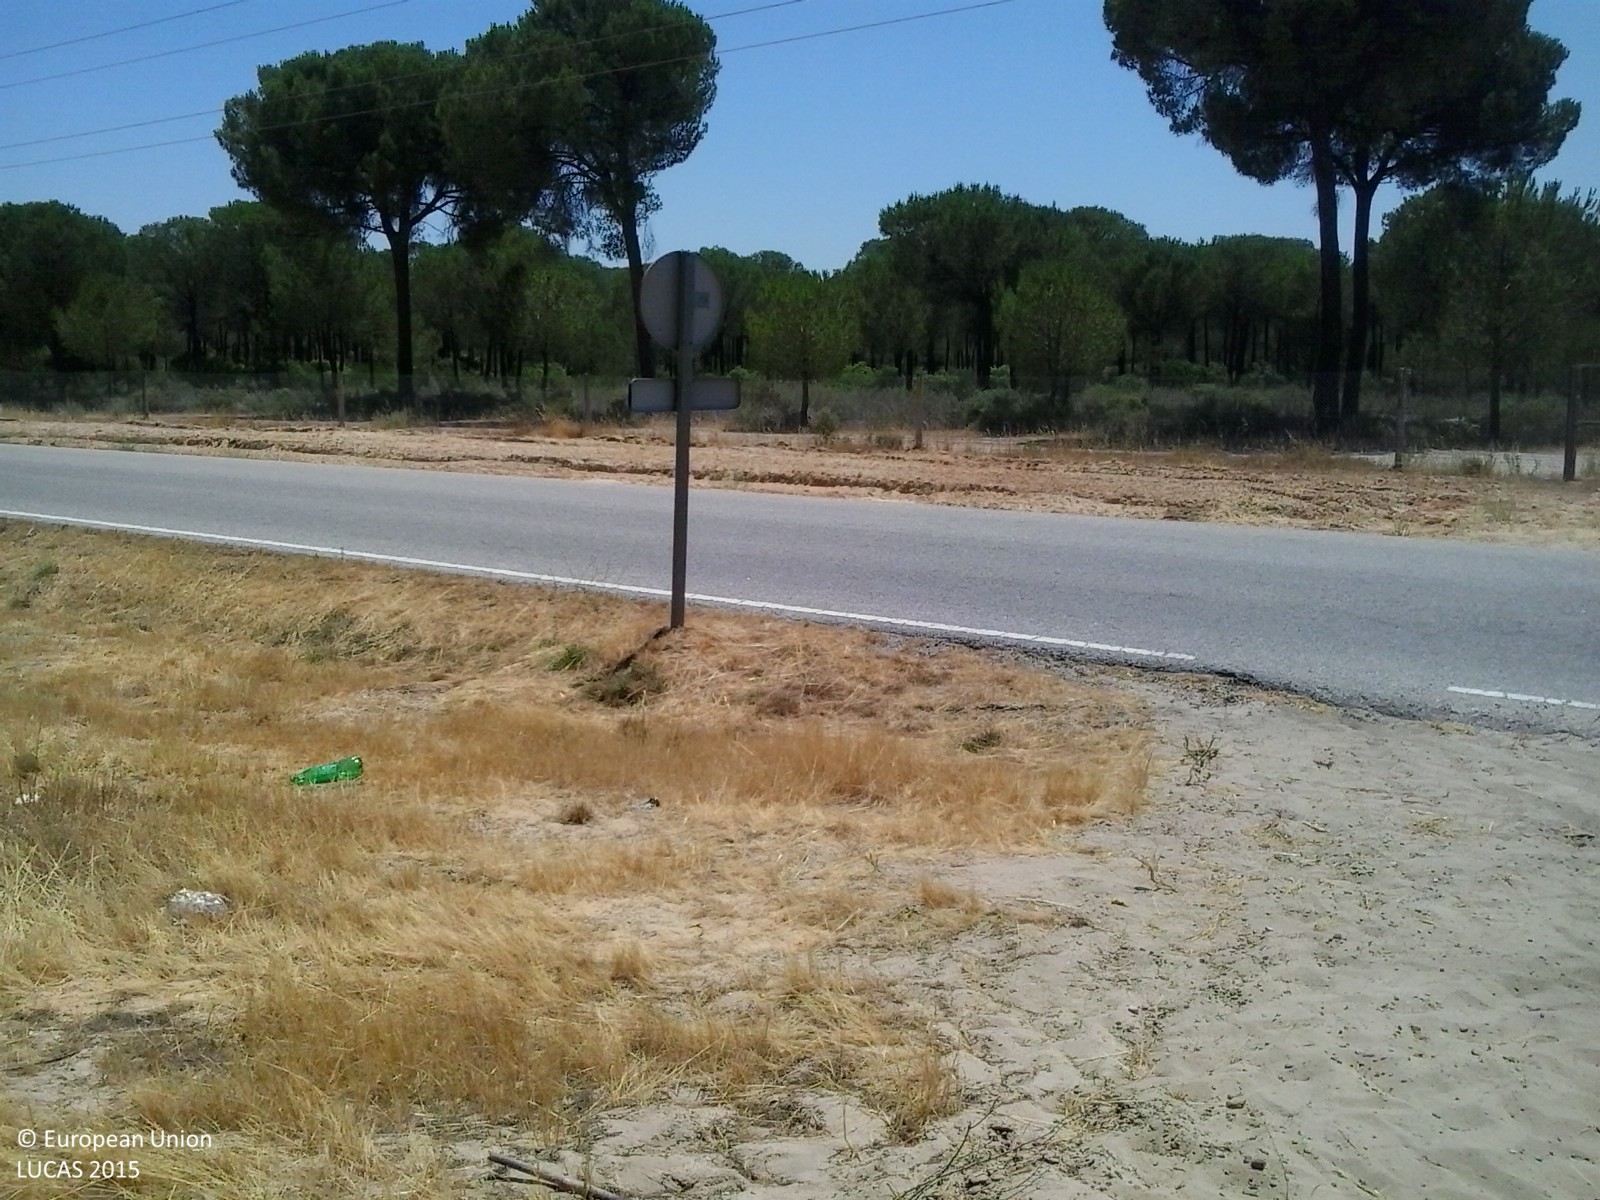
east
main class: Woodland
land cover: Pine dominated coniferous woodland
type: coniferous forest of the mediterranean region
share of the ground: 50 - 75 %
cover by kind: coniferous forest trees 50 %, herbaceous plants 30 %, shrubs 20 %
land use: Forestry
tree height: > 5 m
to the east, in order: Pine dominated coniferous woodland
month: July
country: ES
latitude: 37.2034
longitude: -6.3751
